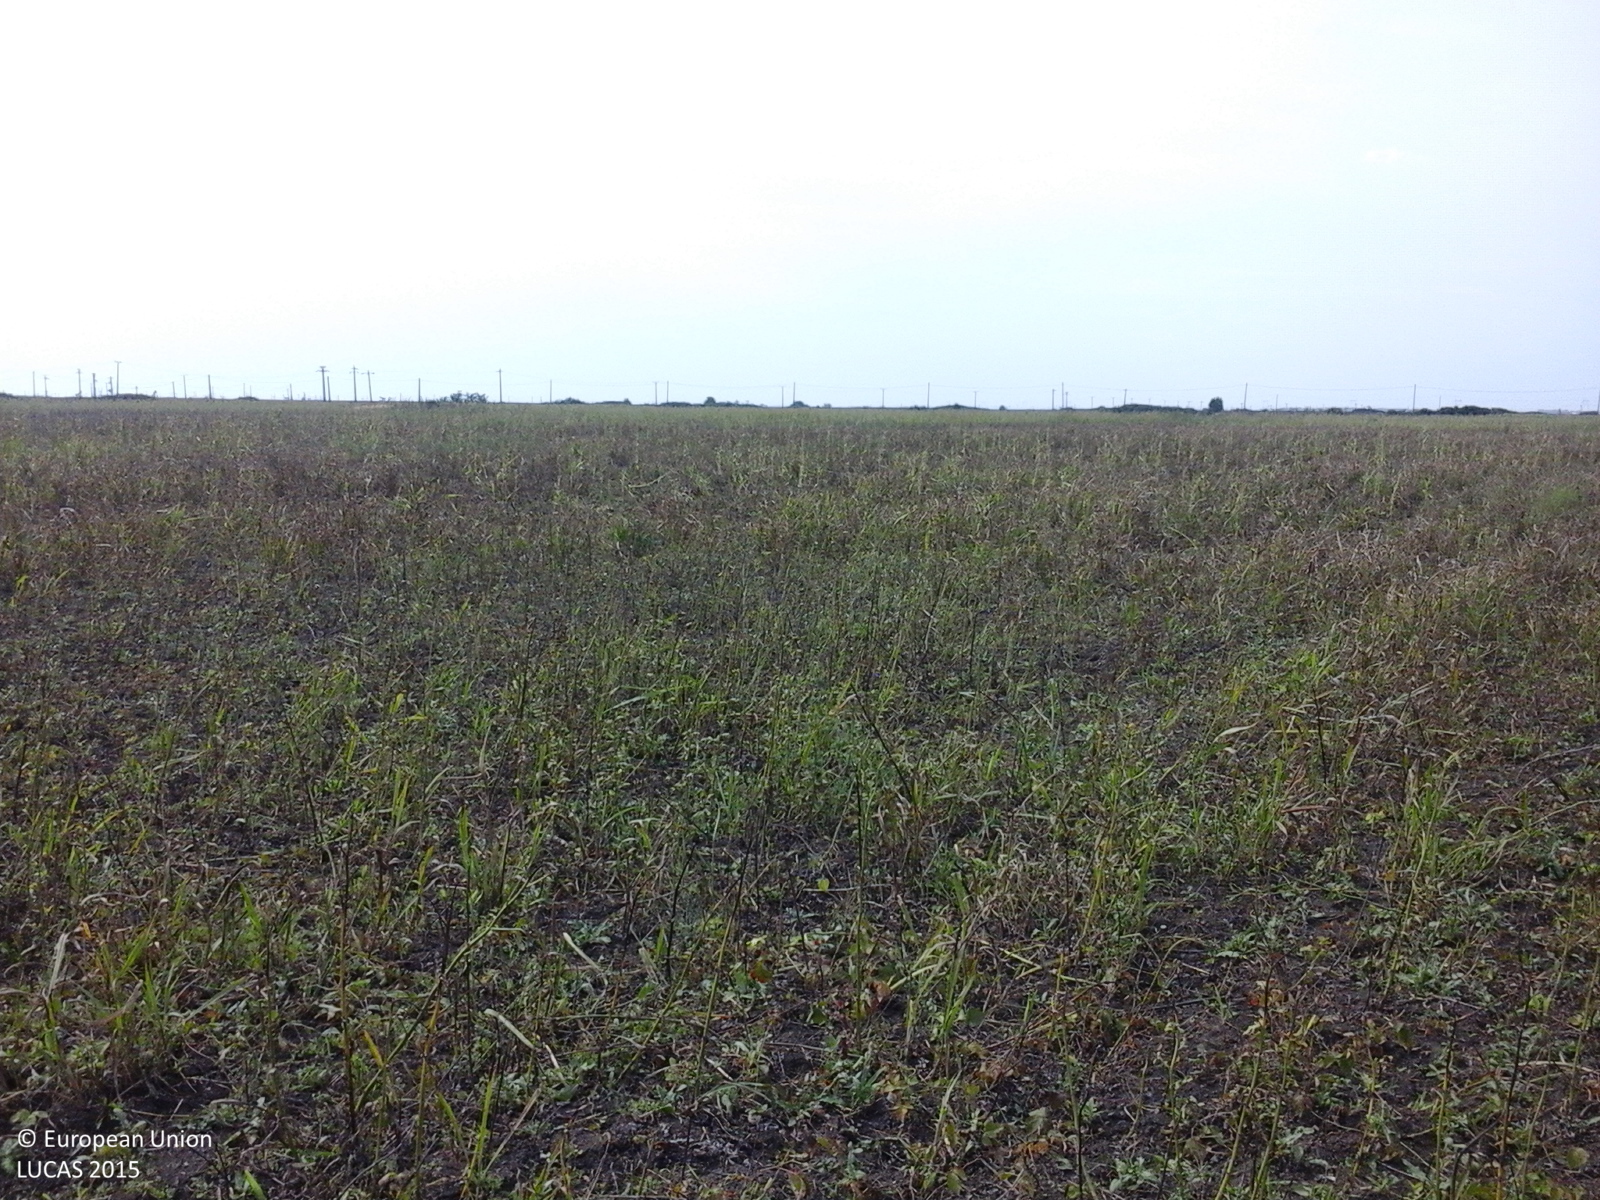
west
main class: Grassland
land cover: Spontaneously vegetated surfaces
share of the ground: > 75 %
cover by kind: herbaceous plants 100 %
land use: Agriculture (excluding fallow land and kitchen gardens)
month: August
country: RO
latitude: 46.2215
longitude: 21.1424
